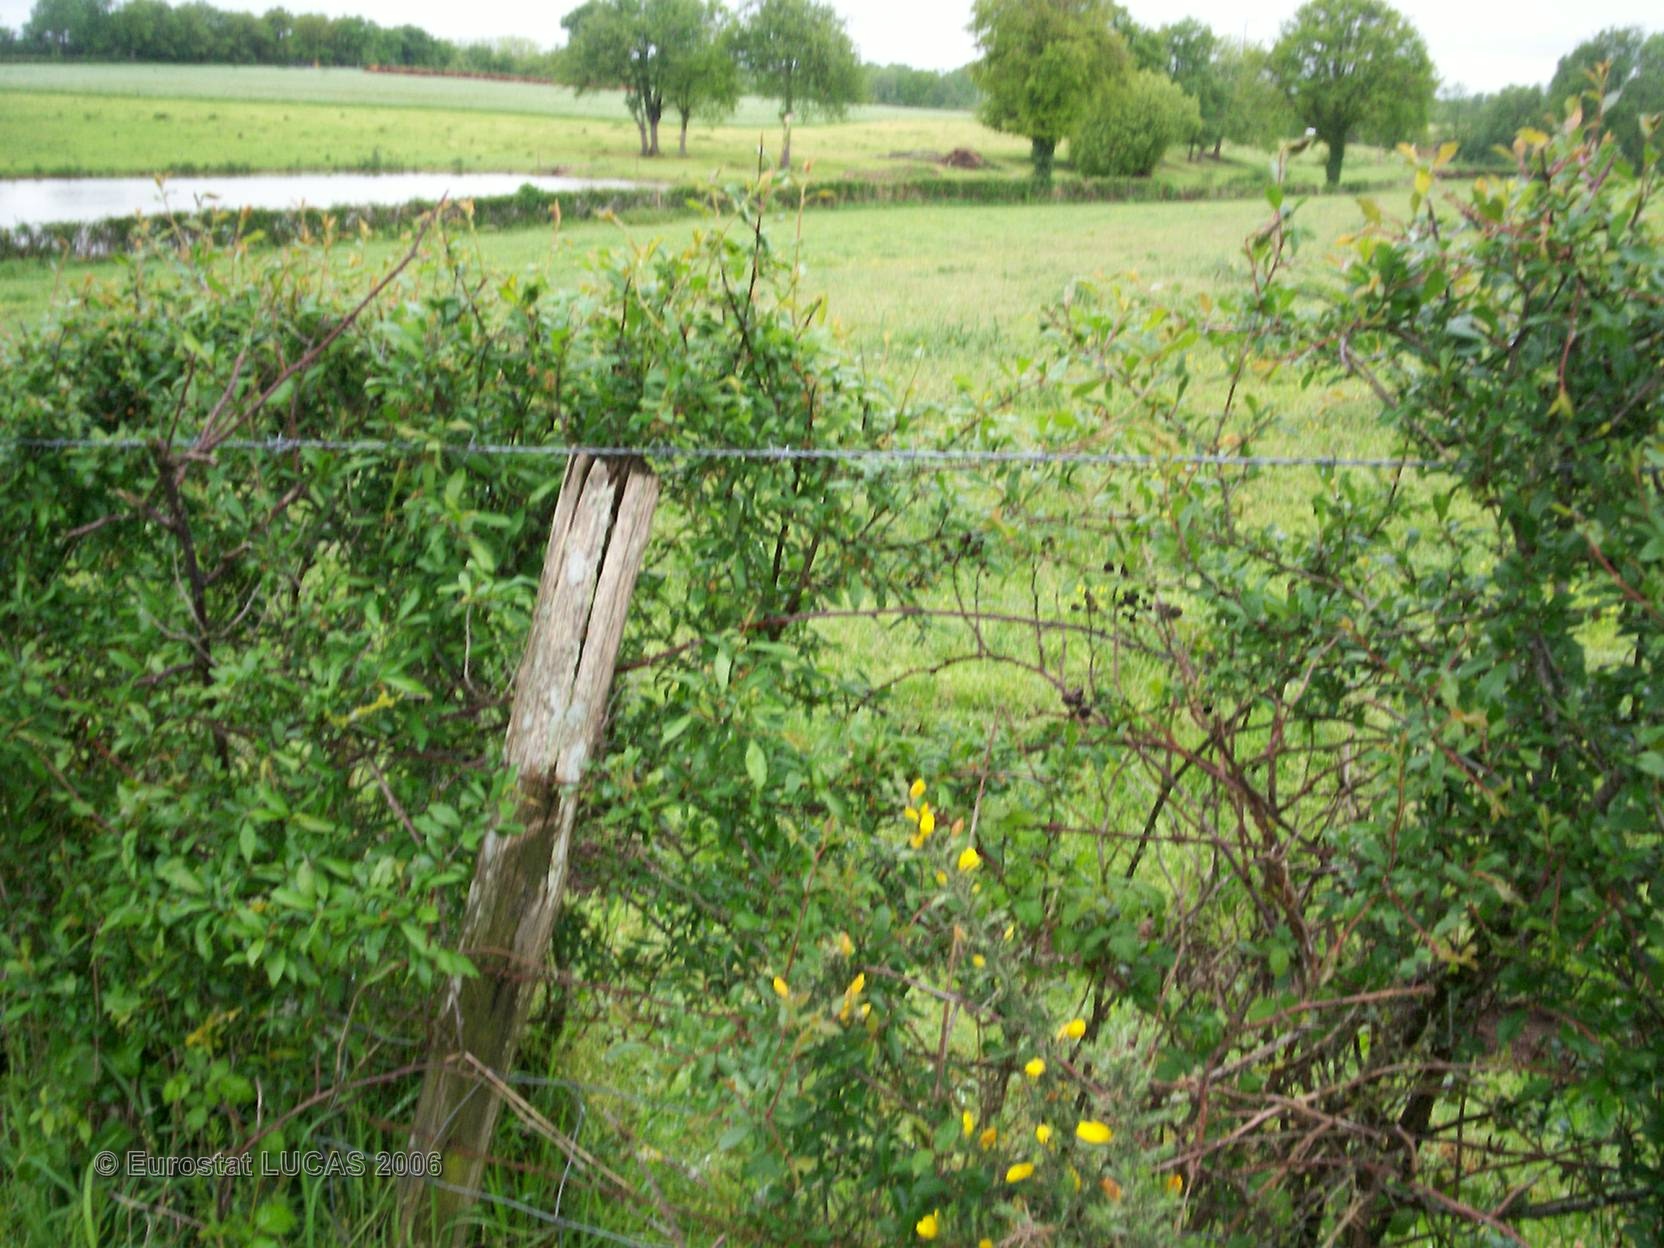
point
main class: Grassland
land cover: Grassland without tree/shrub cover
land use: Agriculture (excluding fallow land and kitchen gardens)
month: May
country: FR
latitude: 46.6885
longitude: -0.2895
